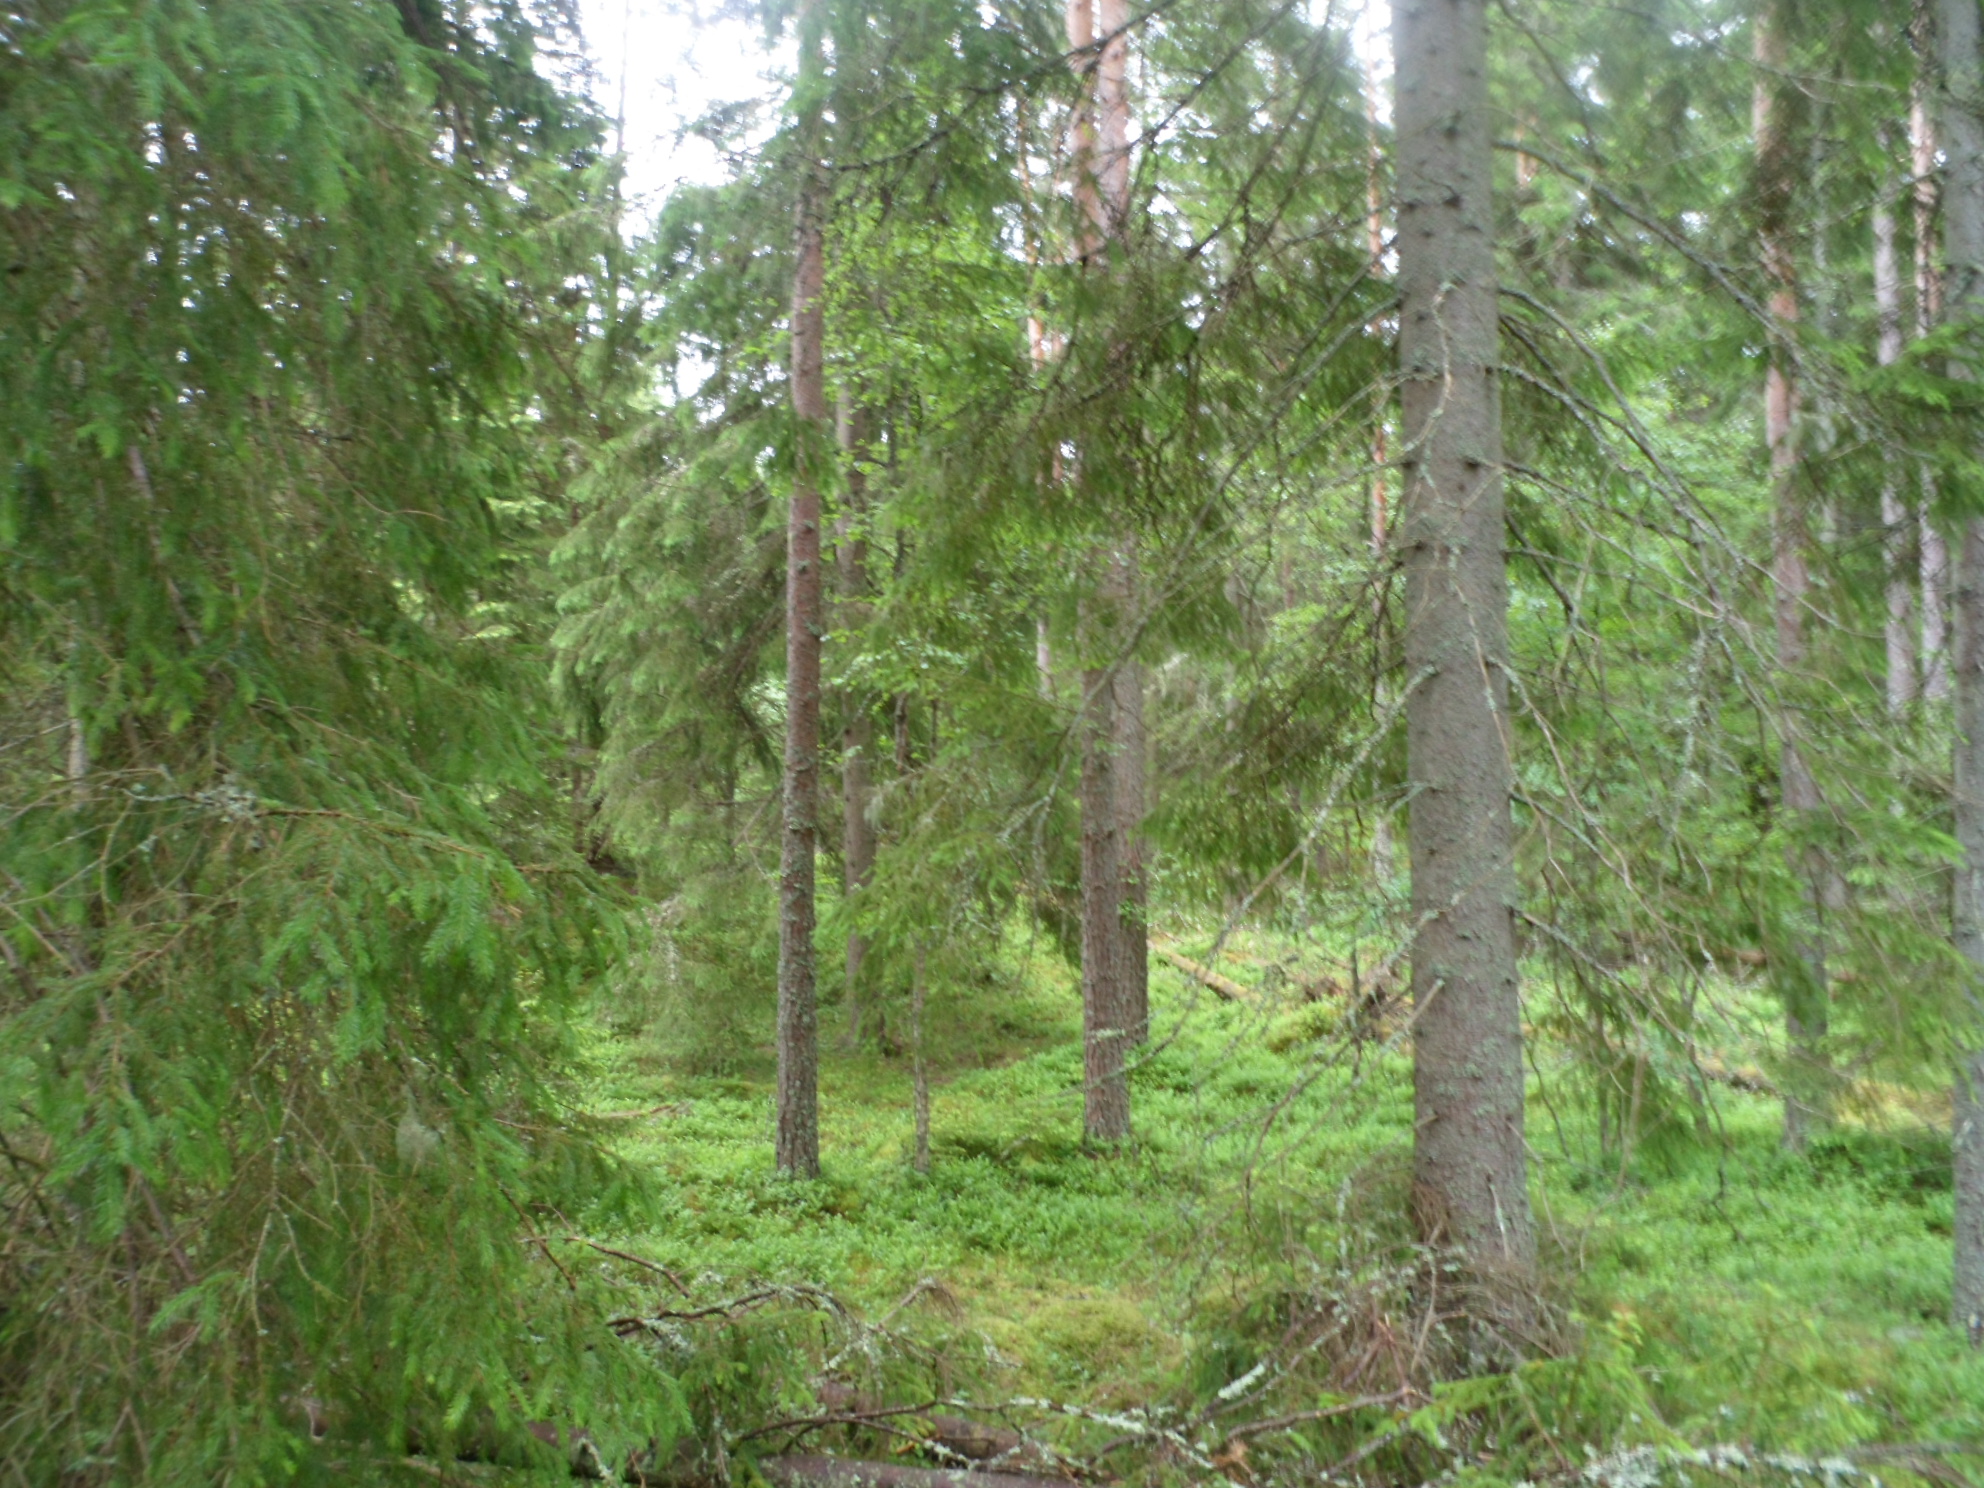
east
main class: Woodland
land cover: Spruce dominated coniferous woodland
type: boreal forest
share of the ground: 50 - 75 %
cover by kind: coniferous forest trees 55 %, shrubs 30 %, lichens and mosses 10 %, herbaceous plants 5 %
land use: Forestry
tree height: > 5 m
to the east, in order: Spruce dominated coniferous woodland; Rivers and streams; Spruce dominated mixed woodland; Spruce dominated coniferous woodland; Spruce dominated mixed woodland; Ditches and canals; Groves; Grassland without tree/shrub cover; Ditches and canals; Groves; Grassland without tree/shrub cover; Ditches and canals; Spruce dominated coniferous woodland
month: June
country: SE
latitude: 57.1455
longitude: 15.2032
